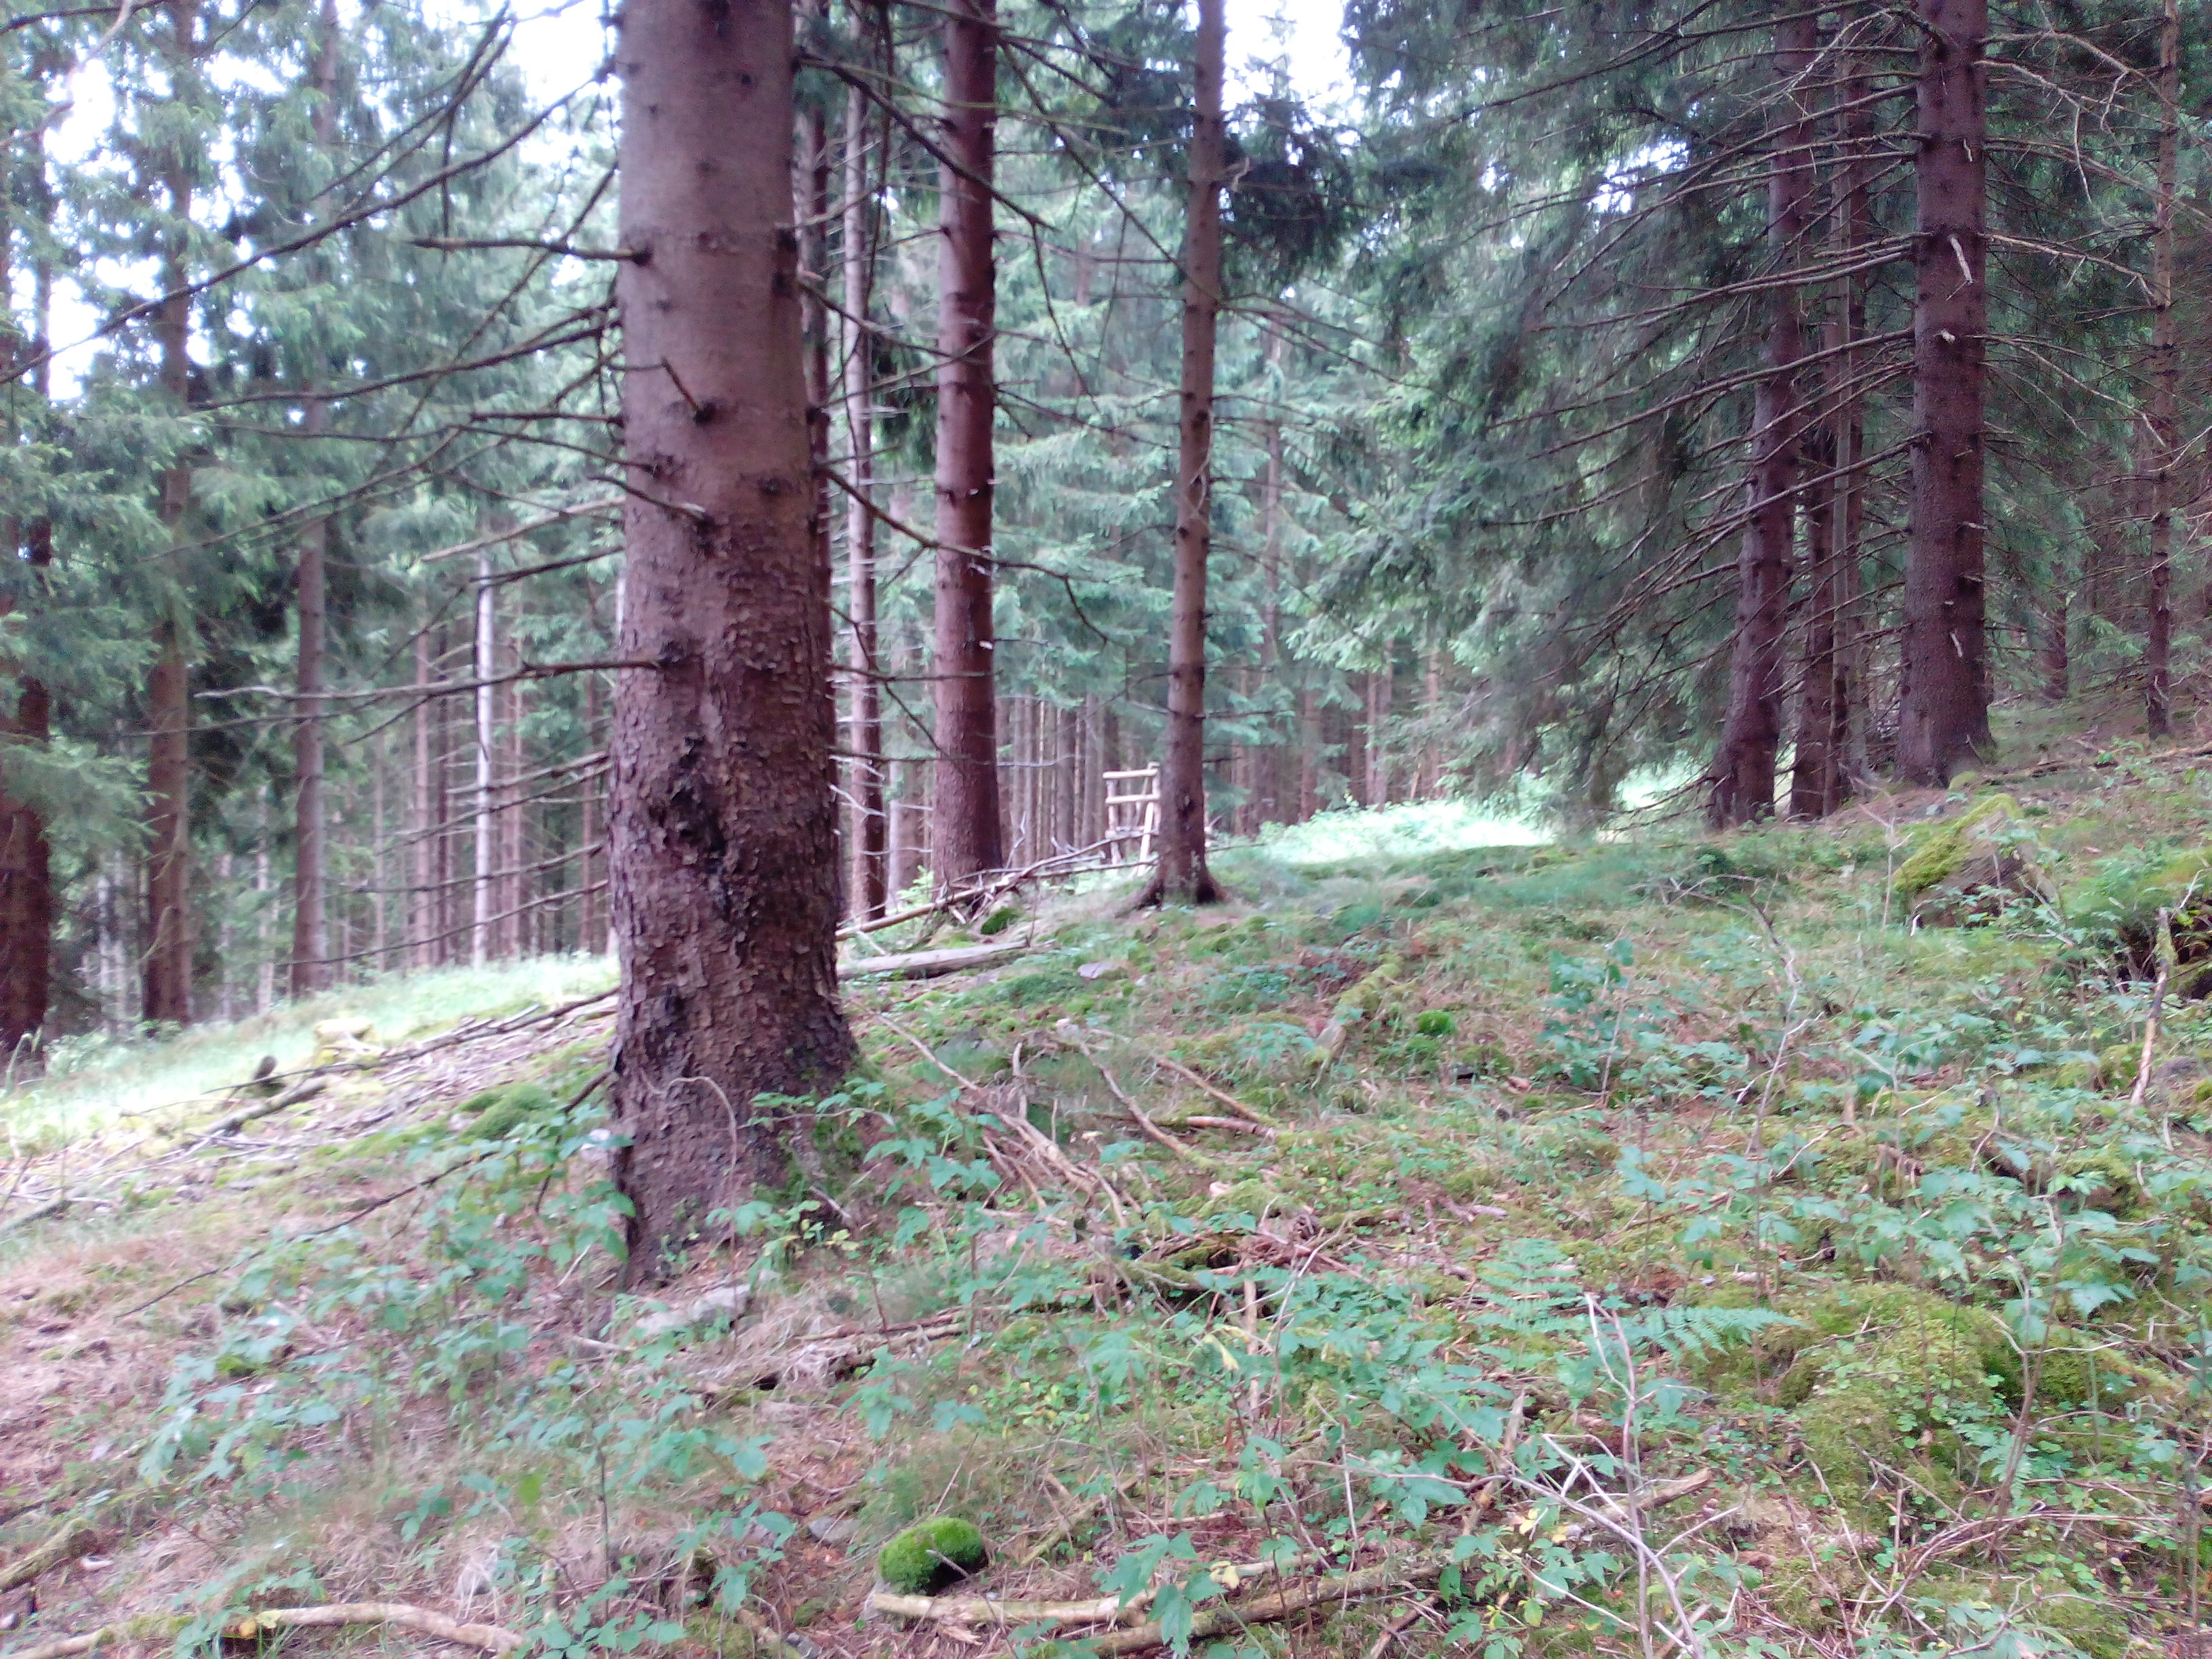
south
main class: Woodland
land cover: Spruce dominated coniferous woodland
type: hemiboreal forest and nemoral coniferous forest and mixed broadleaved-coniferous forest
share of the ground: > 75 %
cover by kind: coniferous forest trees 85 %, herbaceous plants 10 %, shrubs 5 %
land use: Forestry
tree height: > 5 m
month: July
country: DE
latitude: 50.6298
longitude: 10.9469
